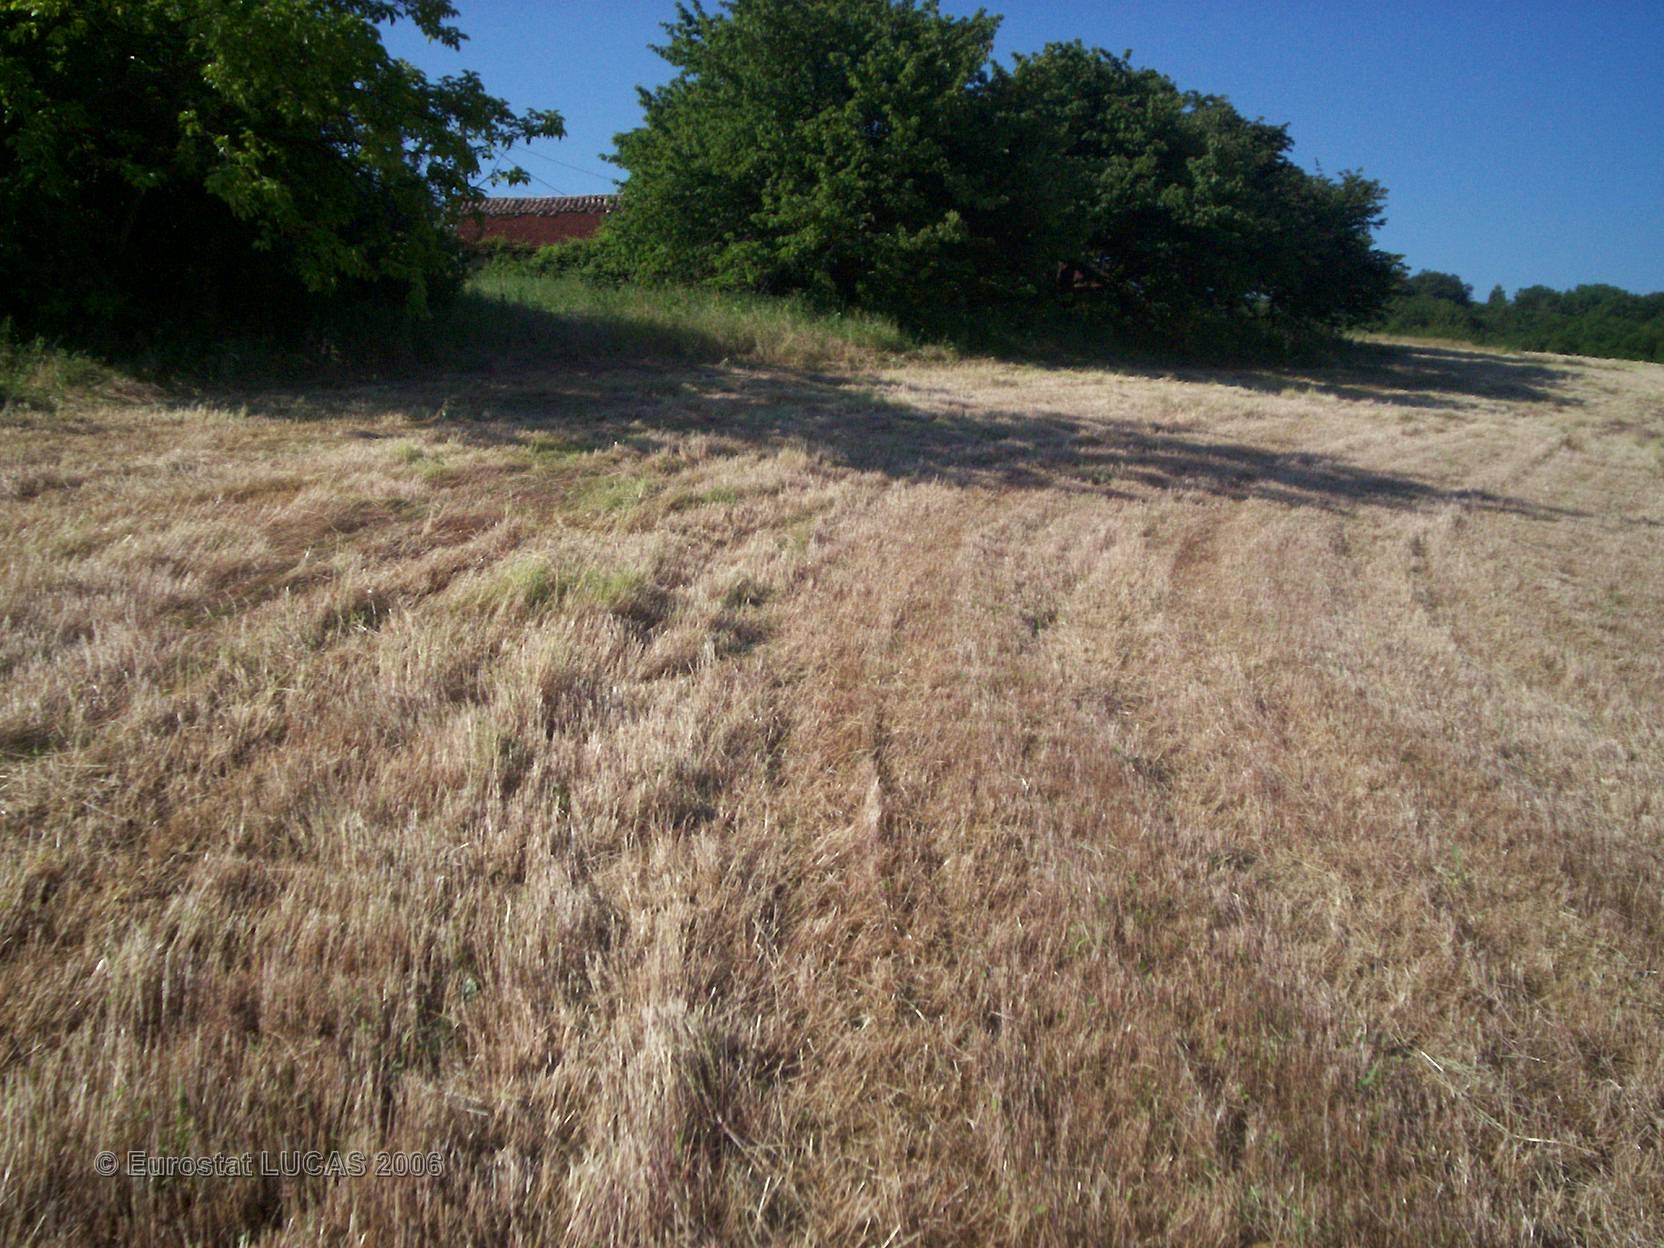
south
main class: Grassland
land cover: Grassland without tree/shrub cover
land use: Agriculture (excluding fallow land and kitchen gardens)
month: June
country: FR
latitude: 45.1275
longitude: 4.8814
